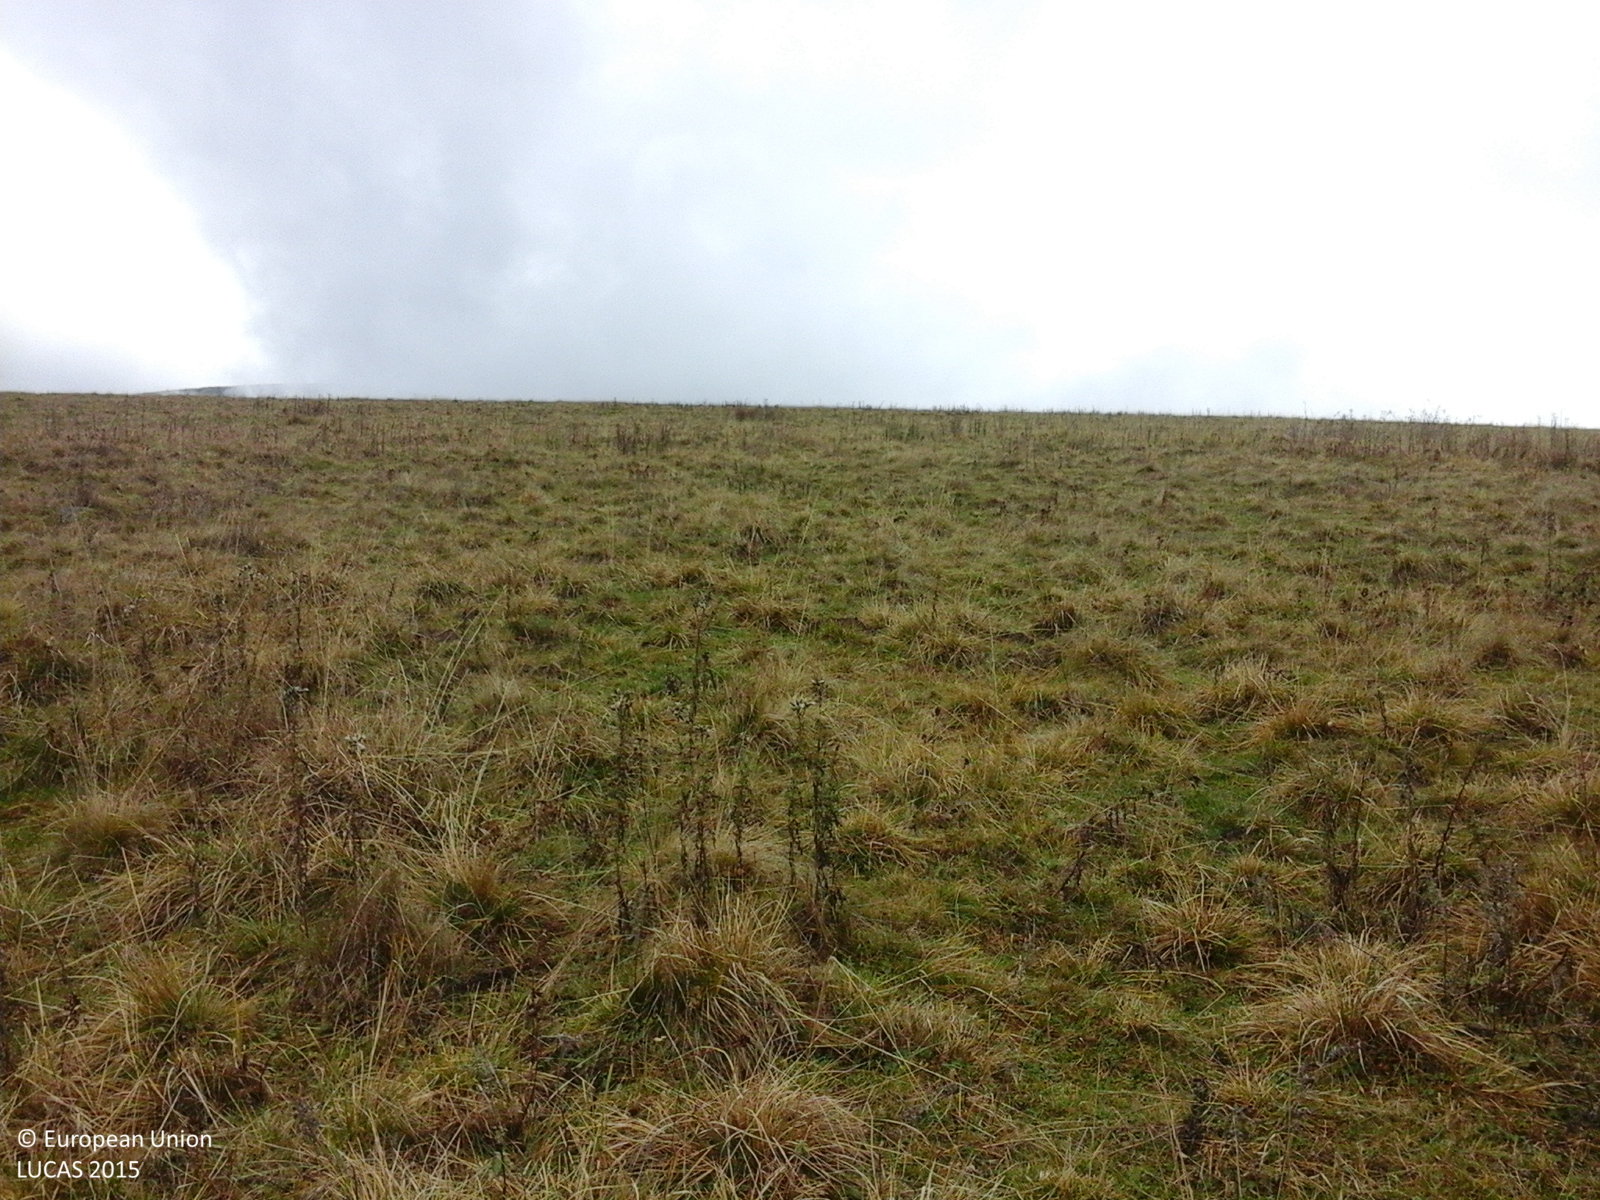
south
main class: Grassland
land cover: Grassland without tree/shrub cover
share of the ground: > 75 %
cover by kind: herbaceous plants 100 %
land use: Agriculture (excluding fallow land and kitchen gardens)
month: October
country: RO
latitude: 46.8648
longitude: 25.6066
